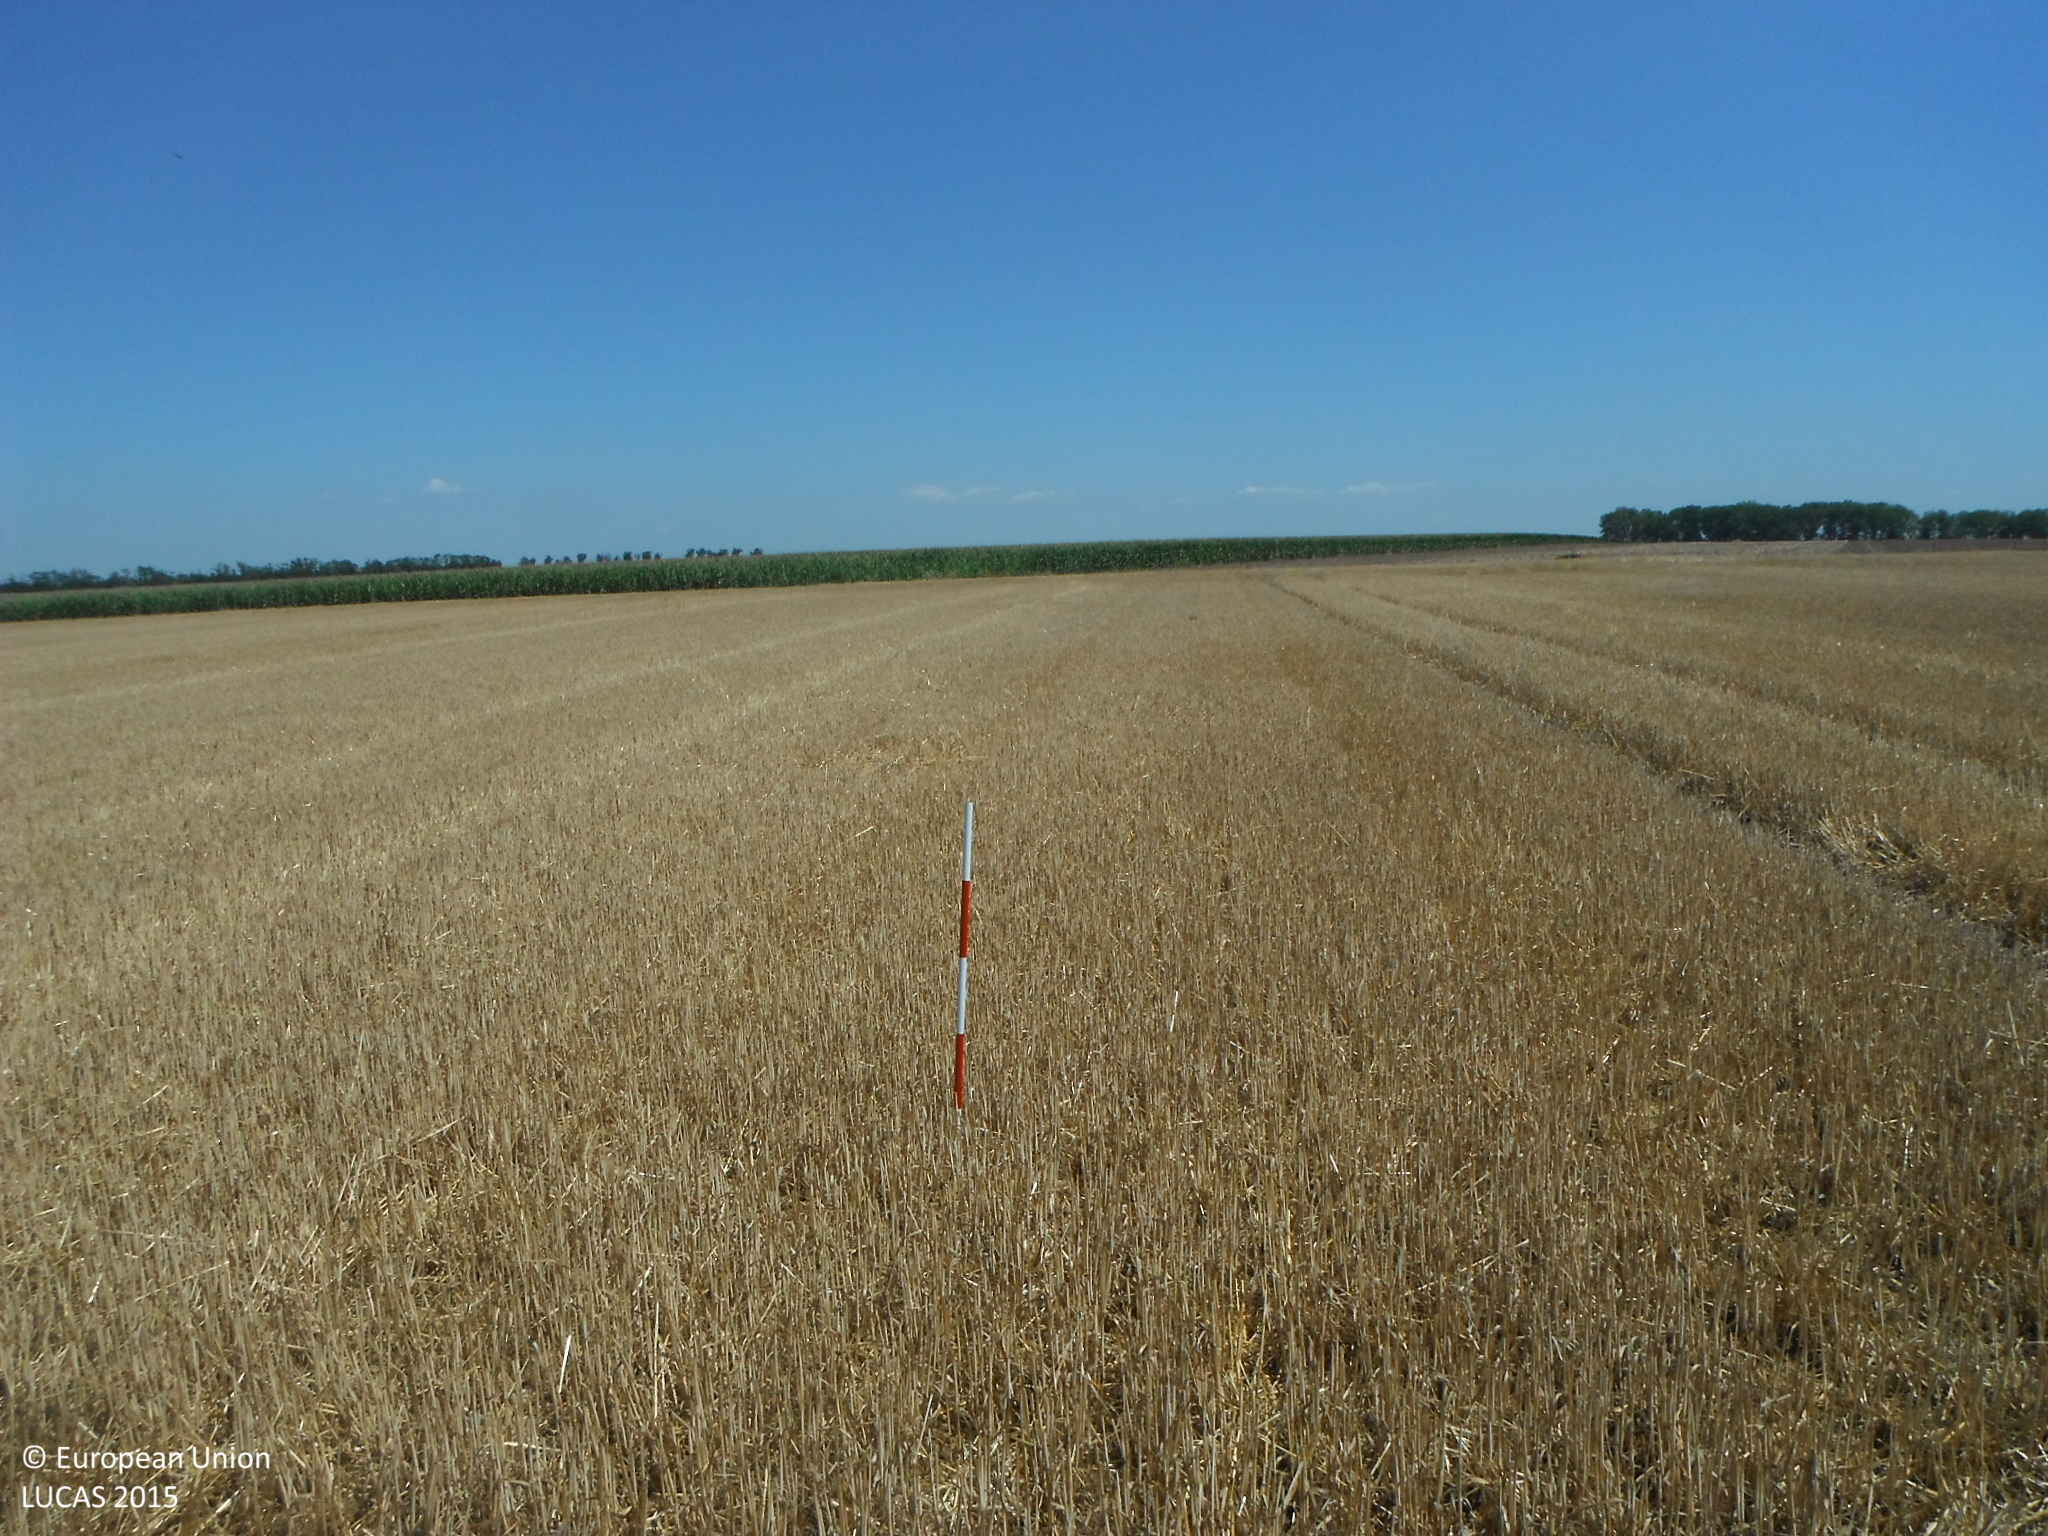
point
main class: Cropland
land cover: Common wheat
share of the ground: 50 - 75 %
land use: Agriculture (excluding fallow land and kitchen gardens)
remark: Harvested field
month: July
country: SK
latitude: 48.5627
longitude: 21.6897
